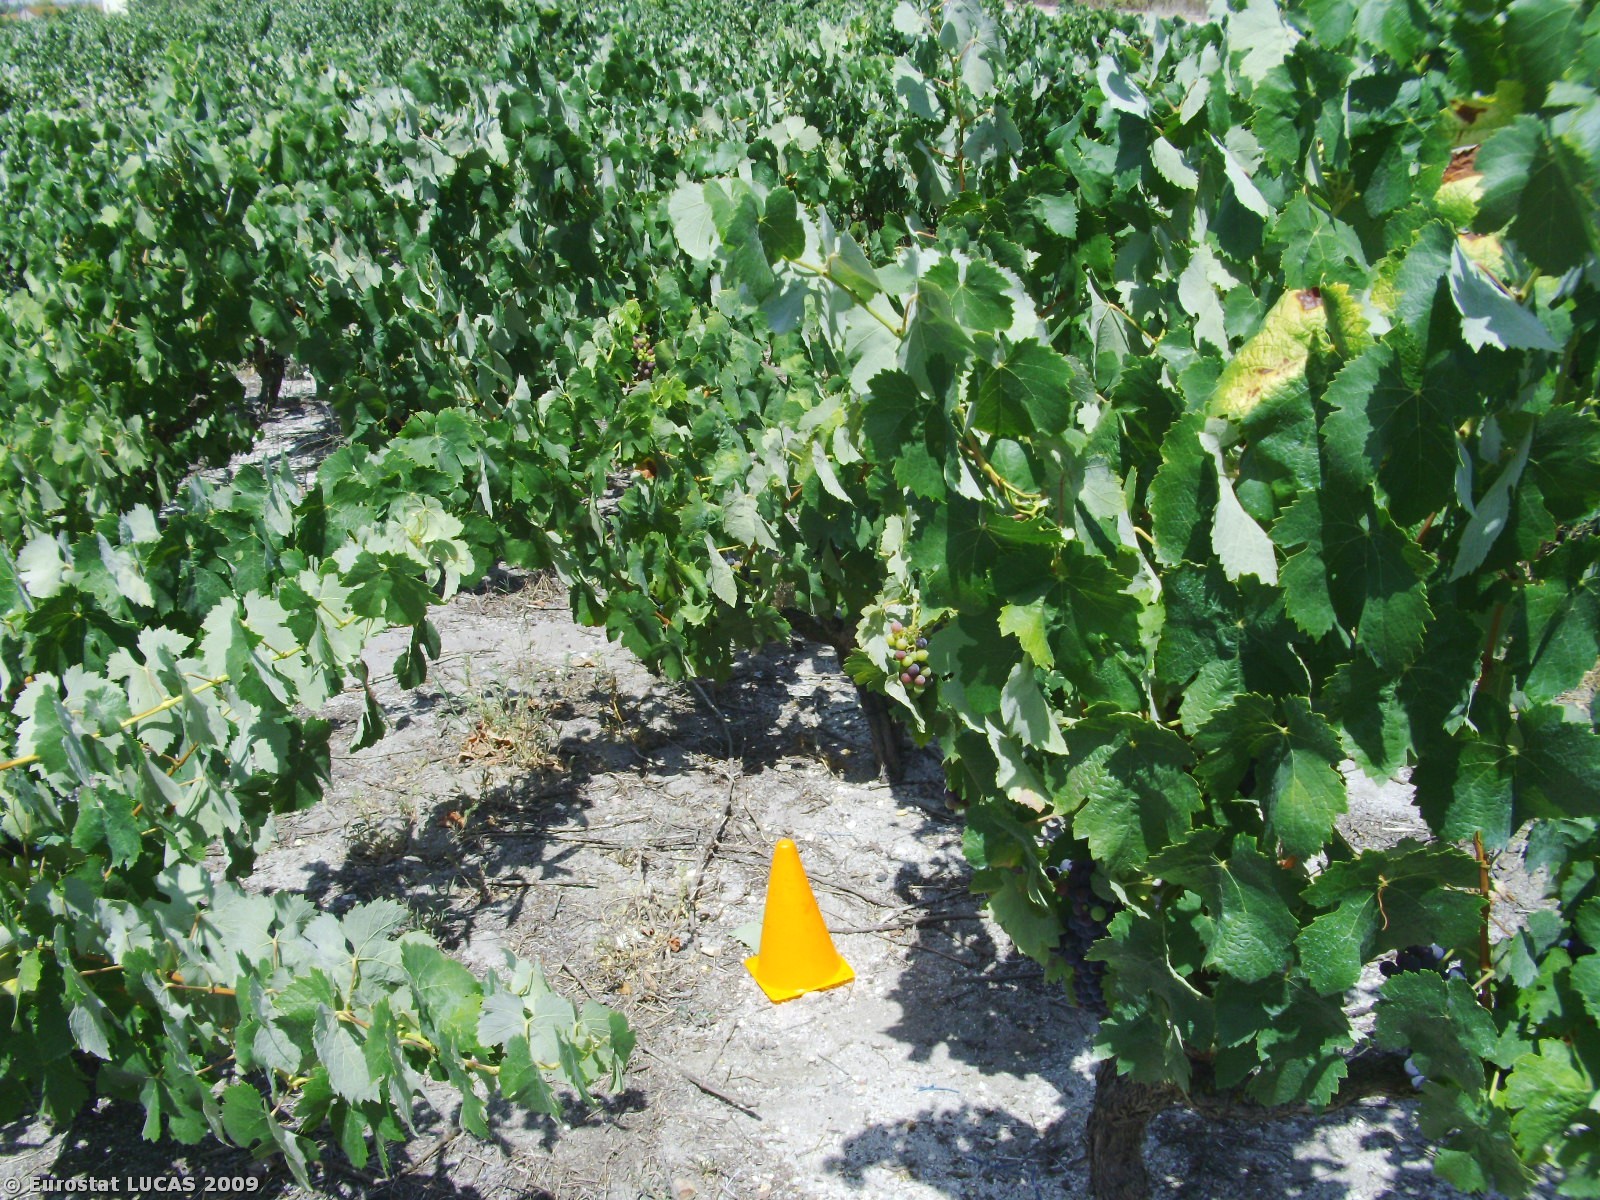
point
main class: Cropland
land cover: Vineyards
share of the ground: 25 - 50 %
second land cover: Spontaneously vegetated surfaces
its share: 50 - 75 %
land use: Agriculture (excluding fallow land and kitchen gardens)
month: July
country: PT
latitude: 38.5735
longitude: -8.8301
